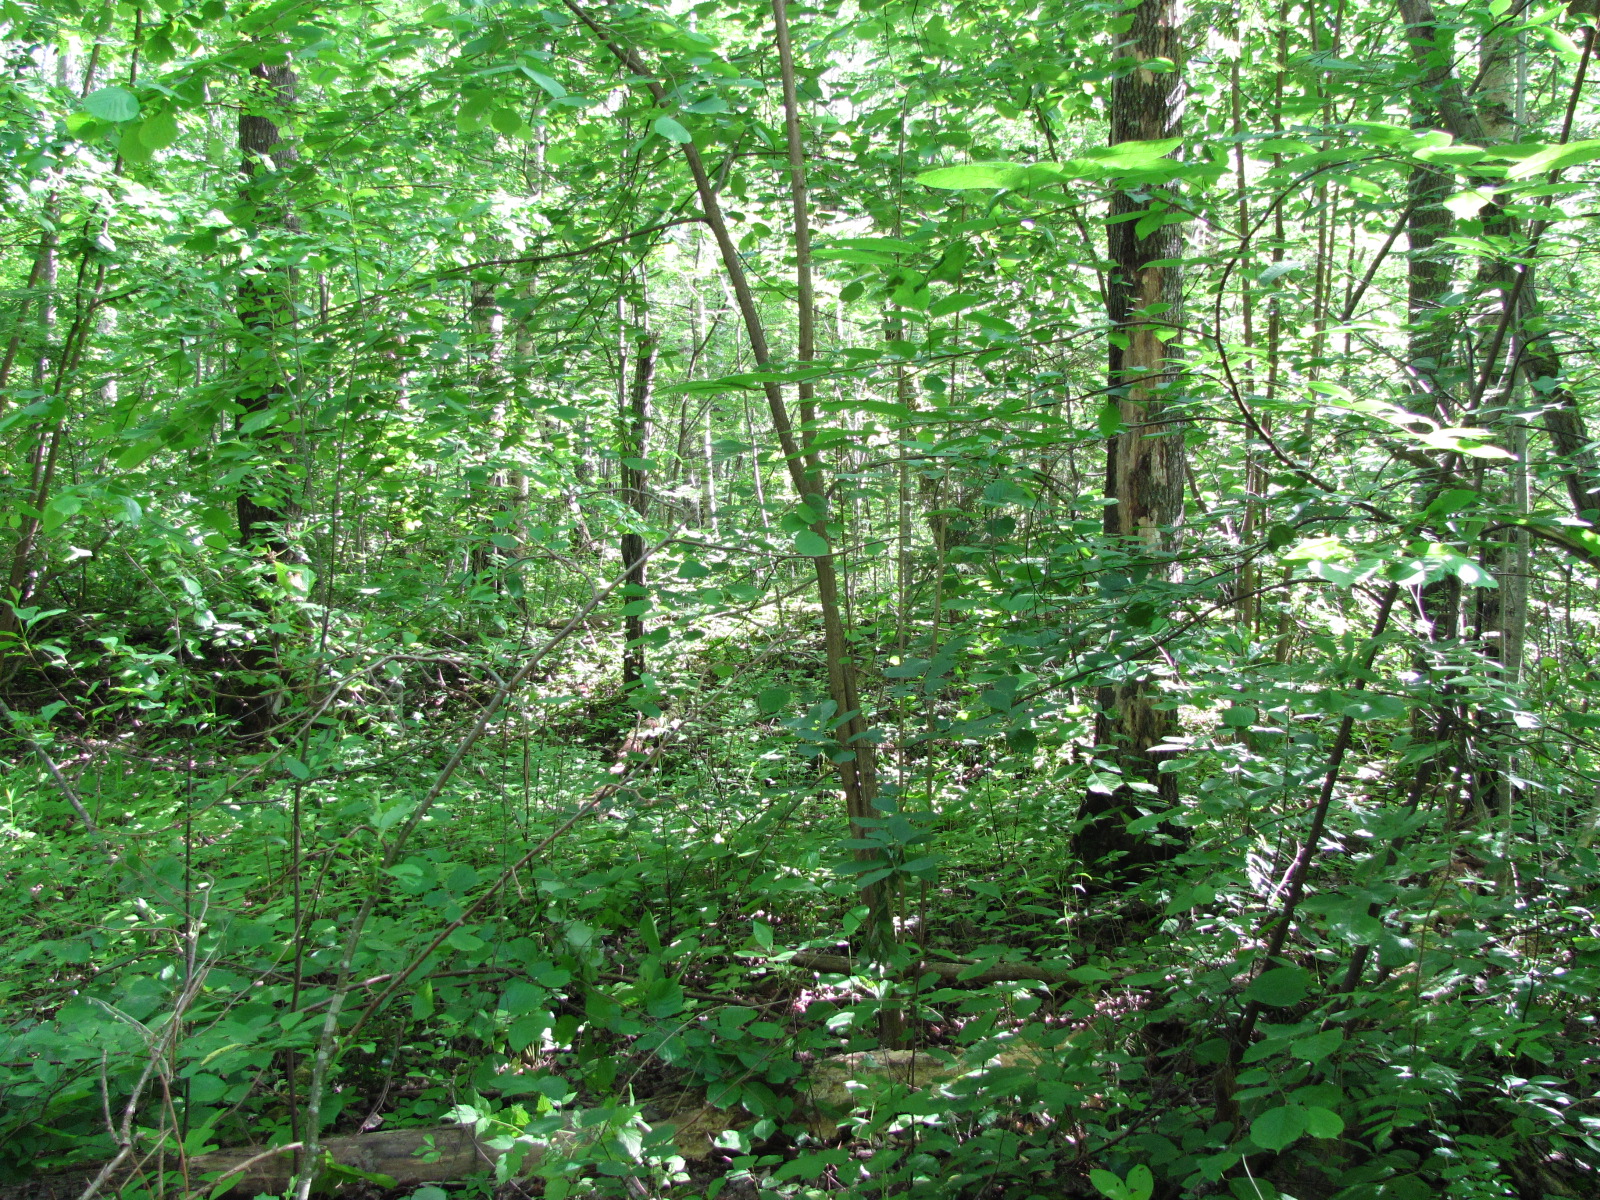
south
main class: Woodland
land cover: Broadleaved woodland
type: non-riverine alder, birch or aspen forest
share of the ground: > 75 %
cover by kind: broadleaved forest trees 100 %
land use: Forestry
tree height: > 5 m
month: June
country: LV
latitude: 56.8725
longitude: 24.3818
